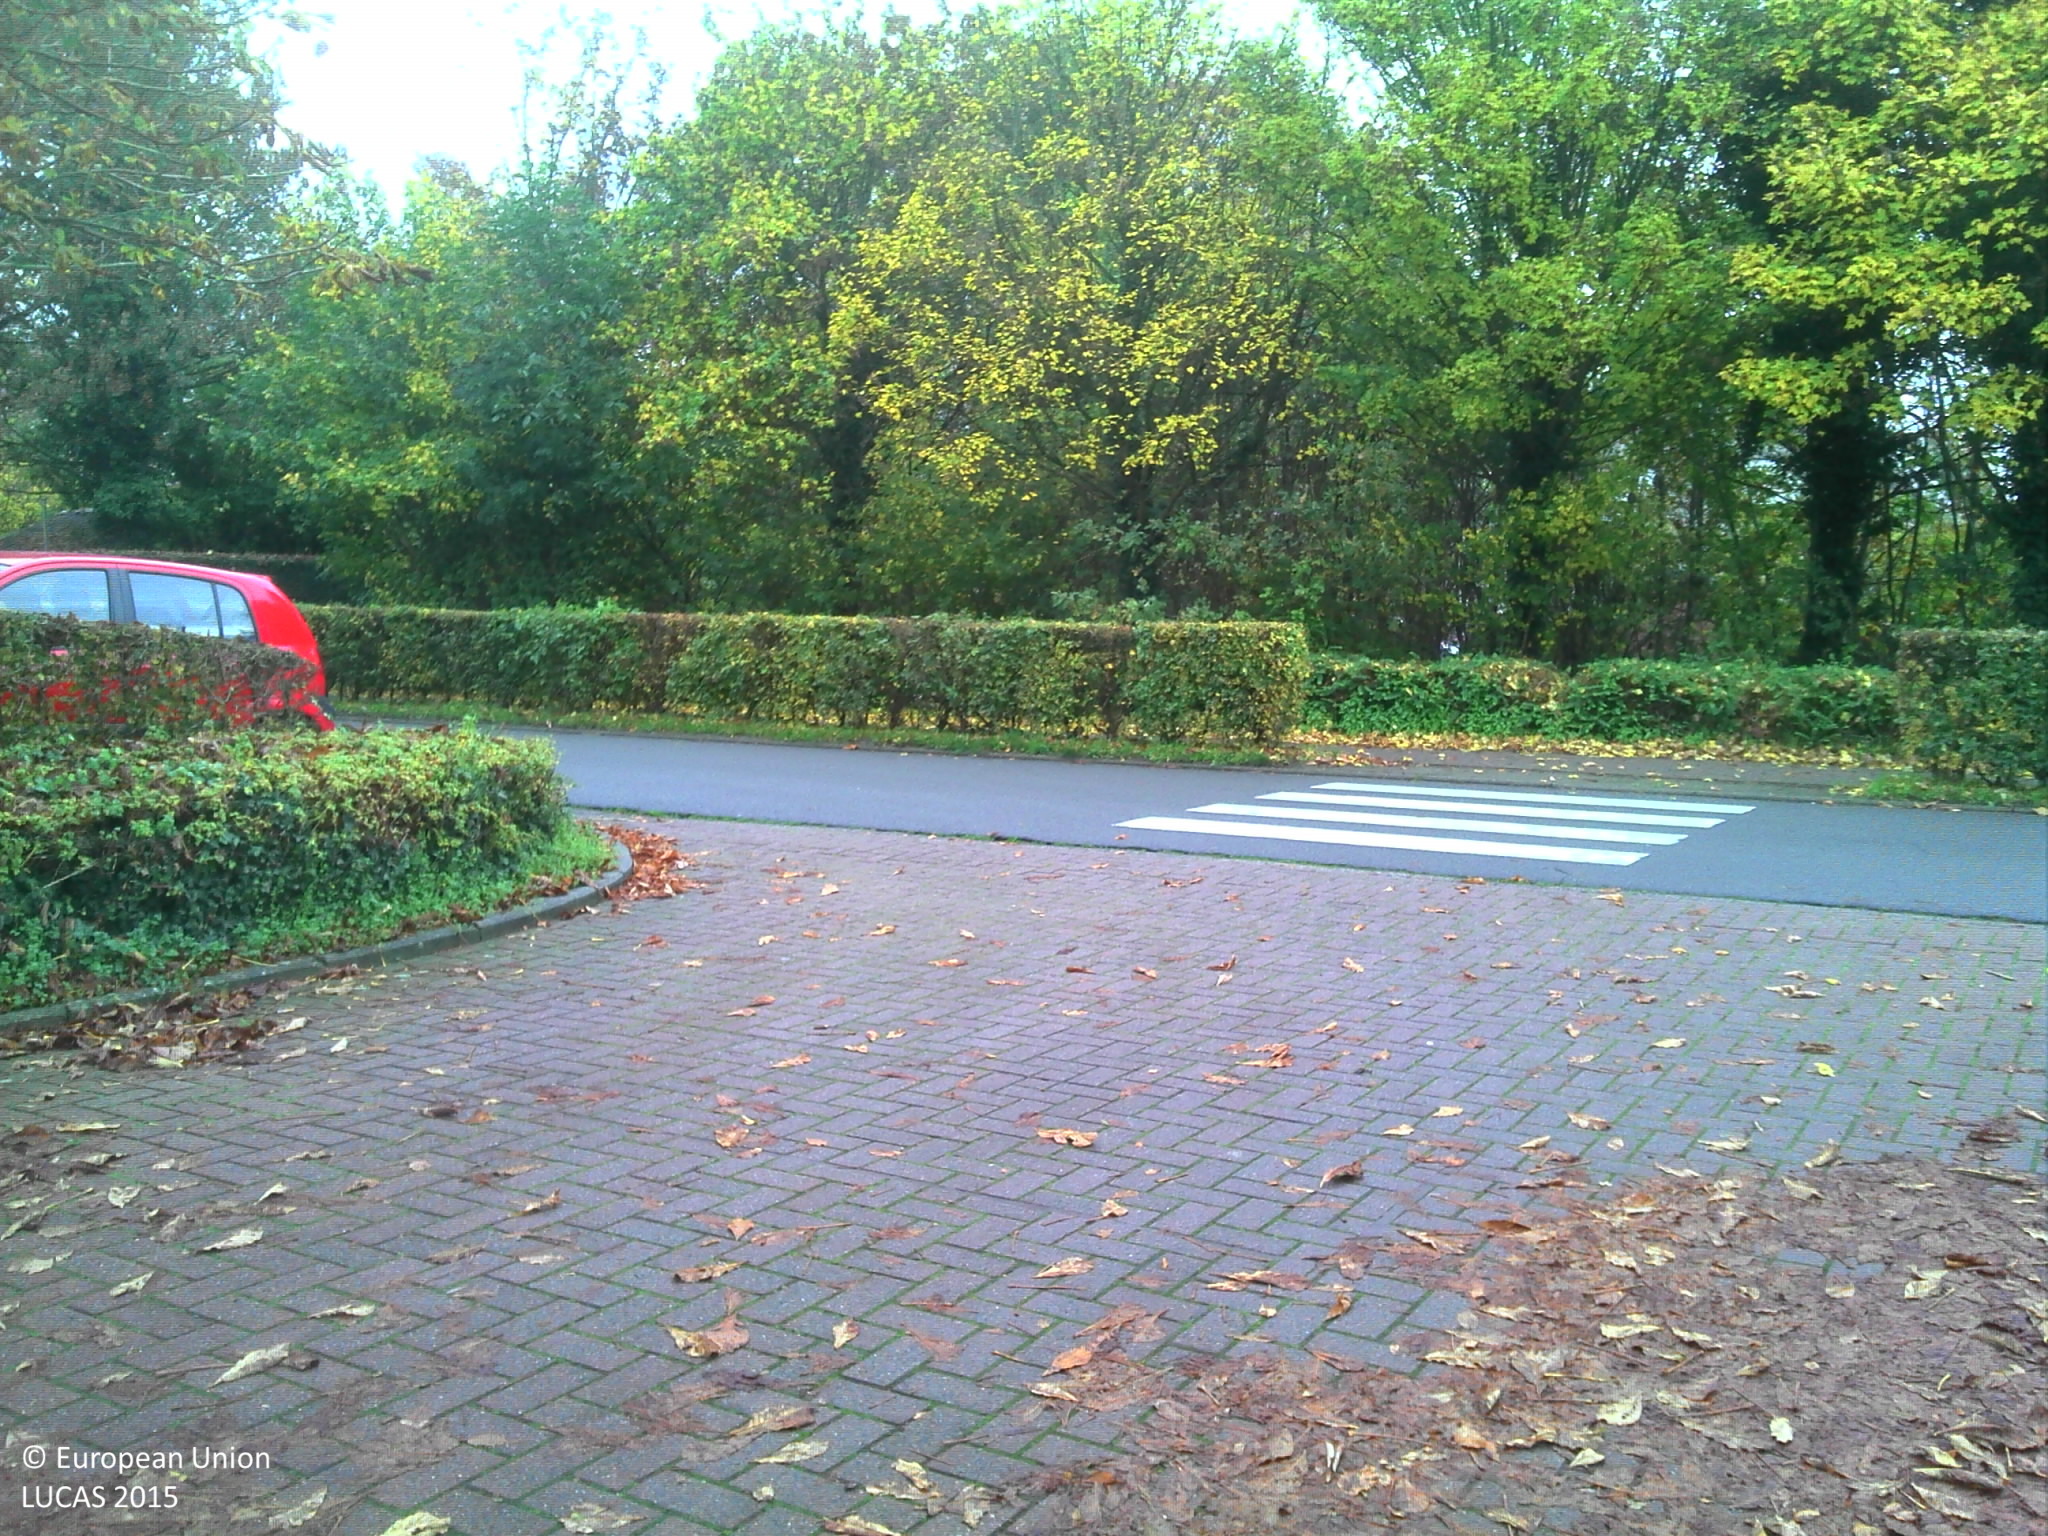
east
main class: Grassland
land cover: Grassland without tree/shrub cover
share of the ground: > 75 %
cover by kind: herbaceous plants 100 %
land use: Residential
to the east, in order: Grassland without tree/shrub cover; Lines of trees; Managed hedges; Paved roads, cycling and walking lanes; Managed hedges; Tracks; Managed hedges; Lines of trees; Grassland without tree/shrub cover; Artificial constructions in urban areas
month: November
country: BE
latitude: 51.1050
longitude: 4.2966
